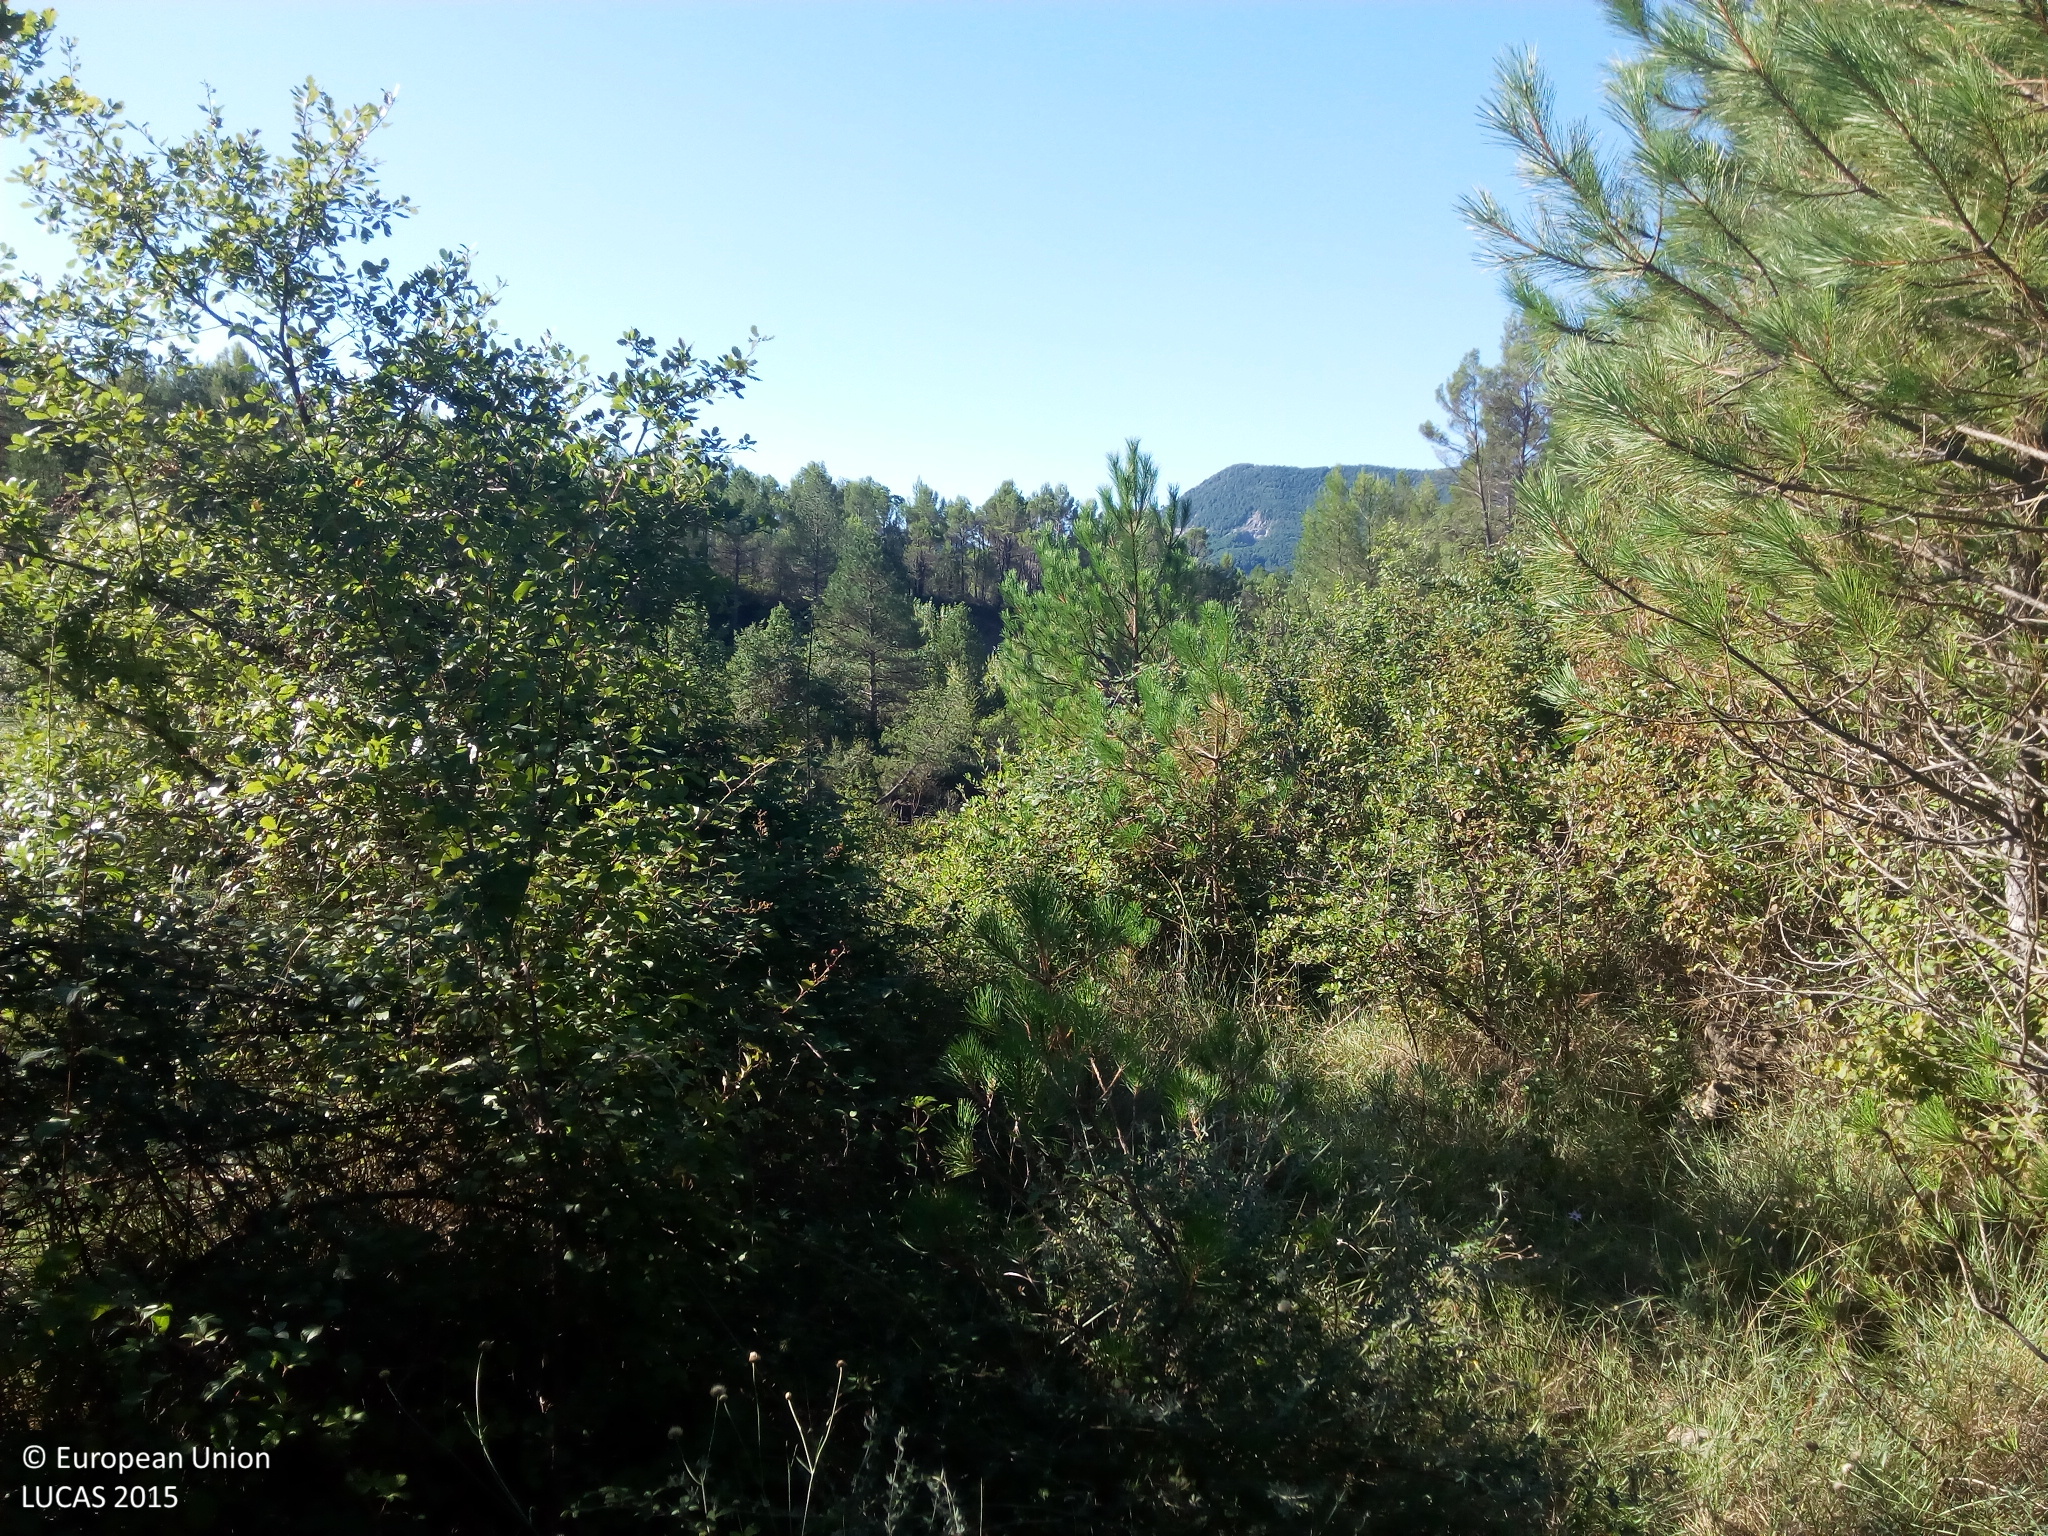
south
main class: Woodland
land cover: Pine dominated mixed woodland
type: alpine coniferous forest
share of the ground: > 75 %
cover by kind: coniferous forest trees 40 %, broadleaved forest trees 30 %, shrubs 20 %, consolidated bare surface 10 %
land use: Semi-natural and natural areas not in use
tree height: > 5 m
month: August
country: ES
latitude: 42.4161
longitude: 0.2211
